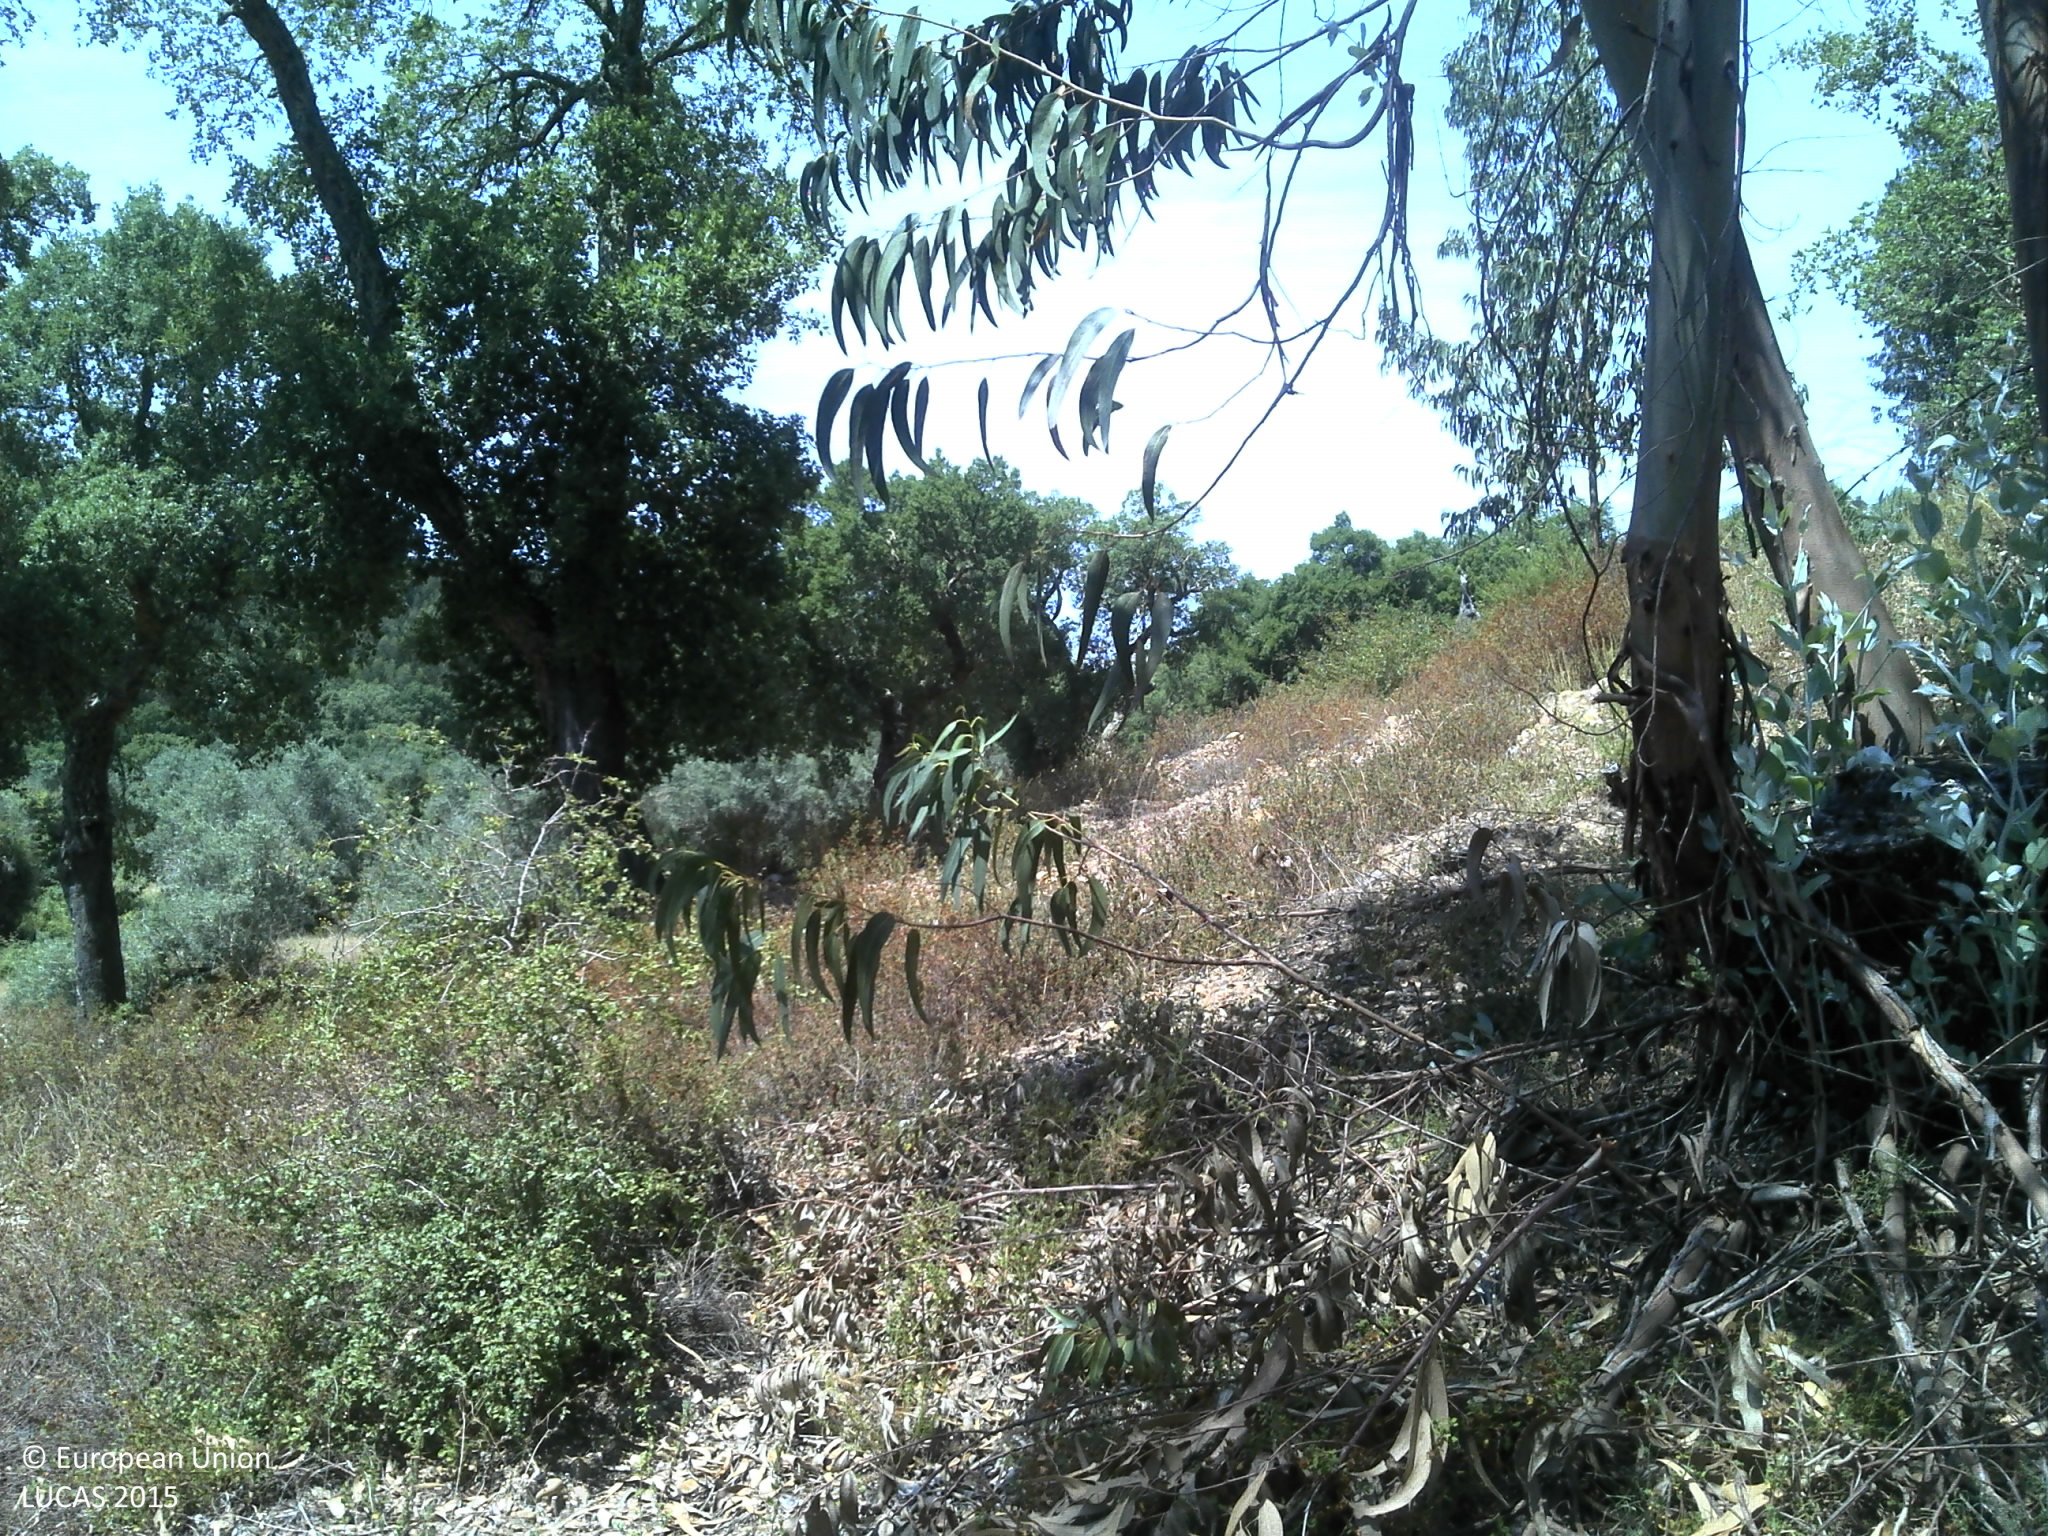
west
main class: Woodland
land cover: Broadleaved woodland
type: exotic forest
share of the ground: 25 - 50 %
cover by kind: broadleaved forest trees 45 %, unconsolidated bare surface 40 %, herbaceous plants 10 %, shrubs 5 %
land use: Forestry
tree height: > 5 m
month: July
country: PT
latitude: 39.3315
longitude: -8.2650
